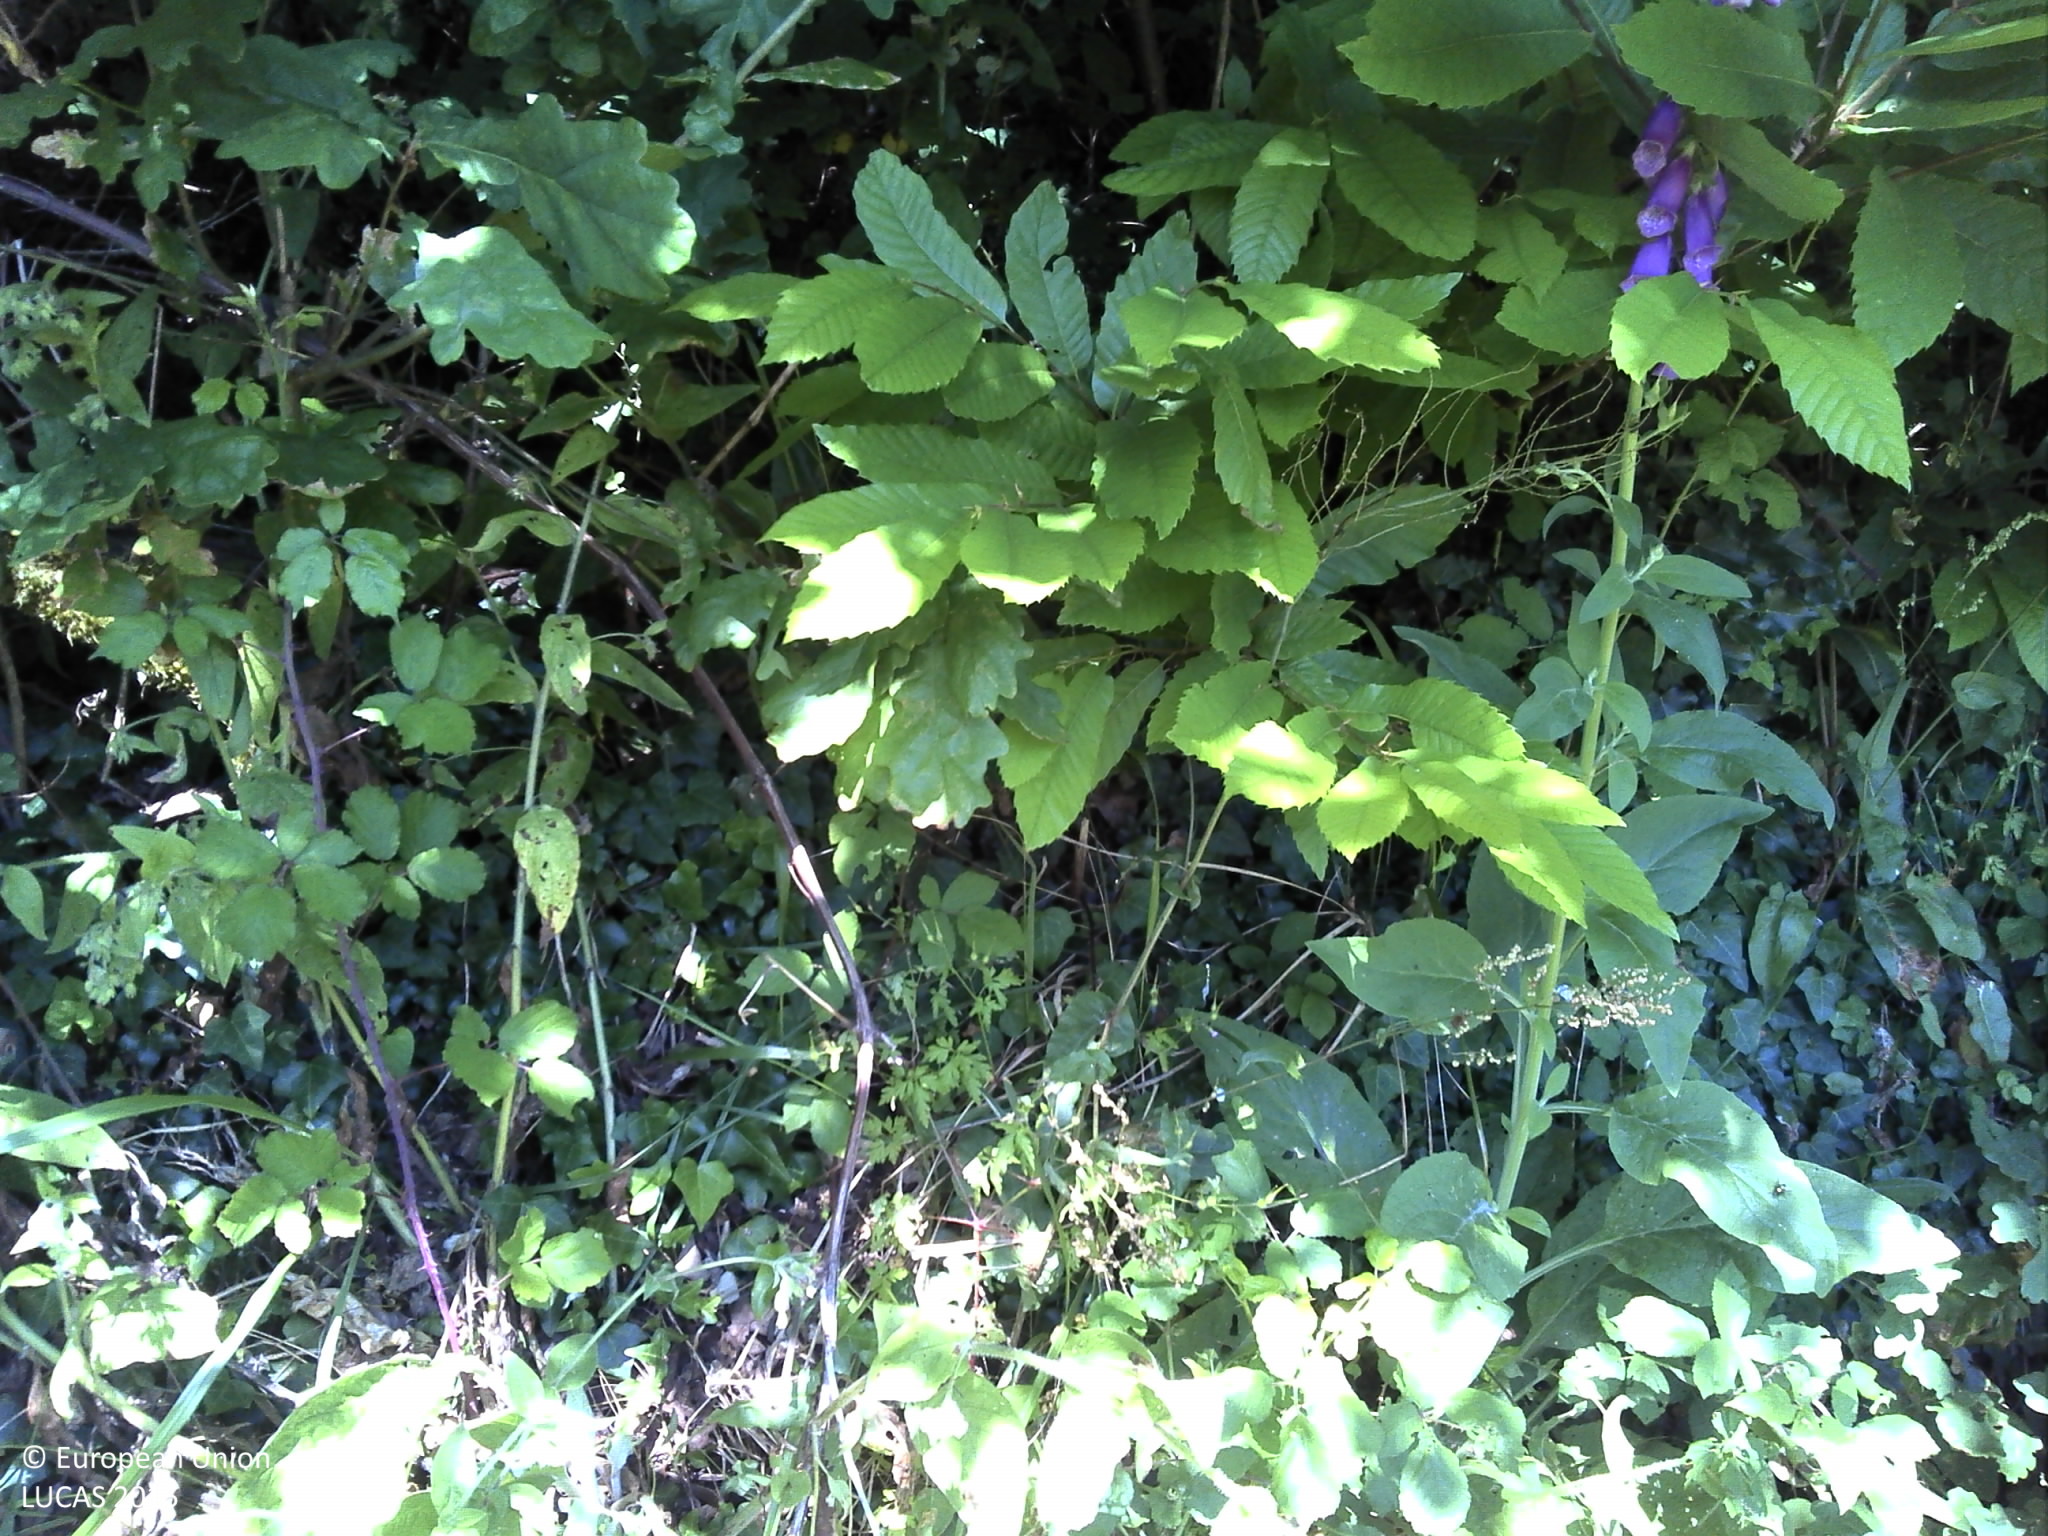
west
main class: Woodland
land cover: Broadleaved woodland
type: mesophytic deciduous forest
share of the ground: > 75 %
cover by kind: broadleaved forest trees 85 %, shrubs 5 %, herbaceous plants 5 %, unconsolidated bare surface 5 %
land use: Semi-natural and natural areas not in use
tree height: > 5 m
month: May
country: PT
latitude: 41.8982
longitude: -8.6692
